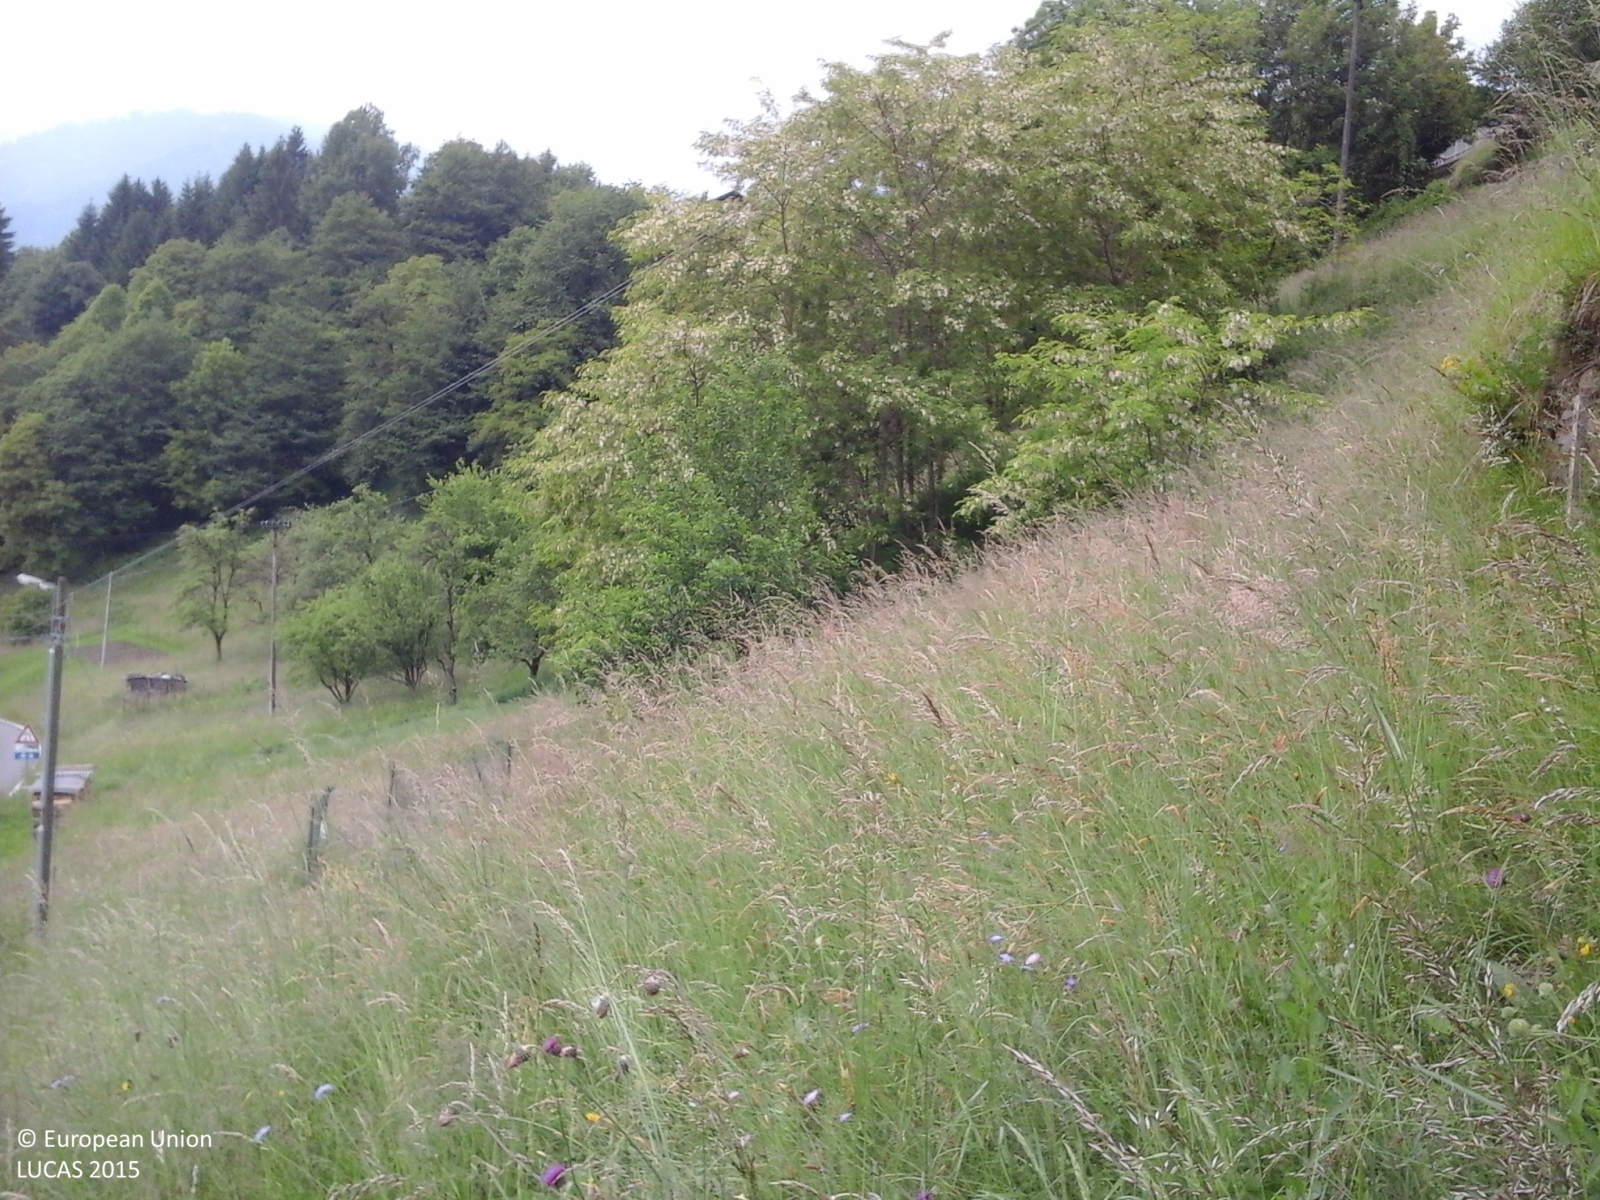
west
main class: Grassland
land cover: Grassland without tree/shrub cover
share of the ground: 50 - 75 %
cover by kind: herbaceous plants 70 %, consolidated bare surface 30 %
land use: Semi-natural and natural areas not in use
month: May
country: IT
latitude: 46.1568
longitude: 11.7458
